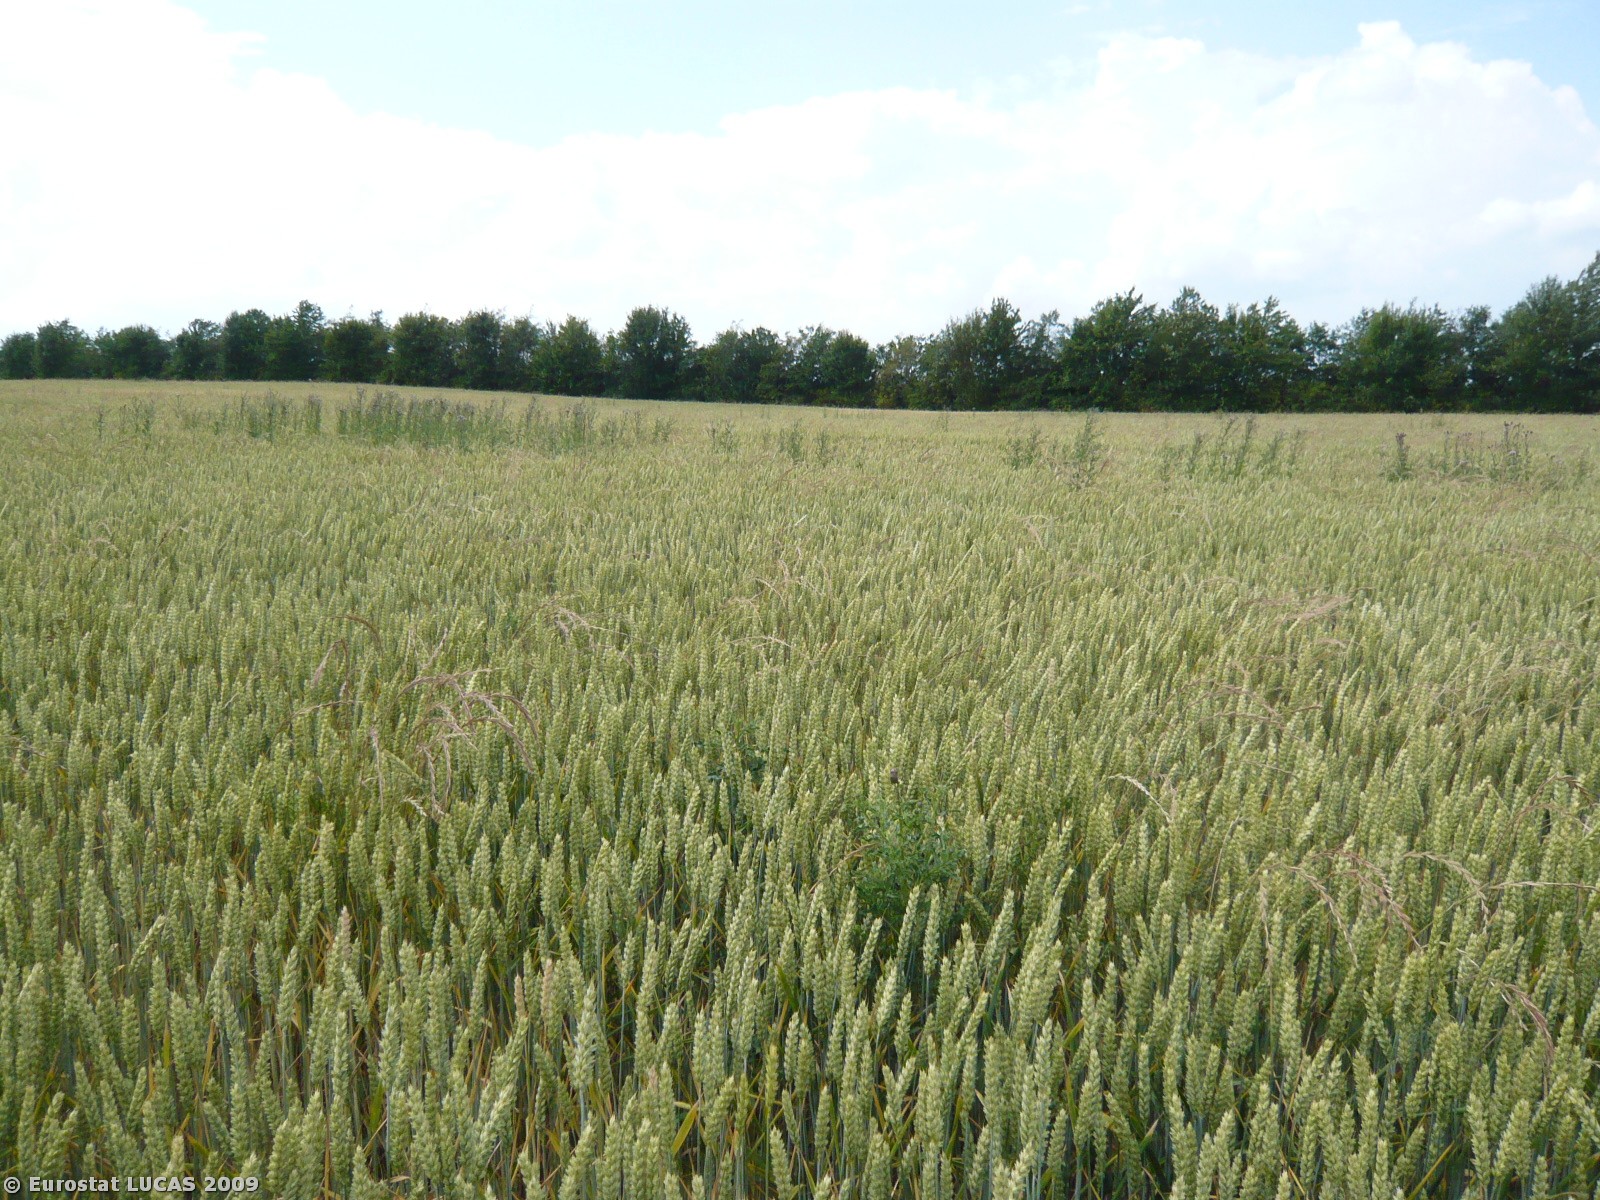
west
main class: Cropland
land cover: Common wheat
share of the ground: > 75 %
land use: Agriculture (excluding fallow land and kitchen gardens)
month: July
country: DK
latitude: 55.5226
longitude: 10.1424
